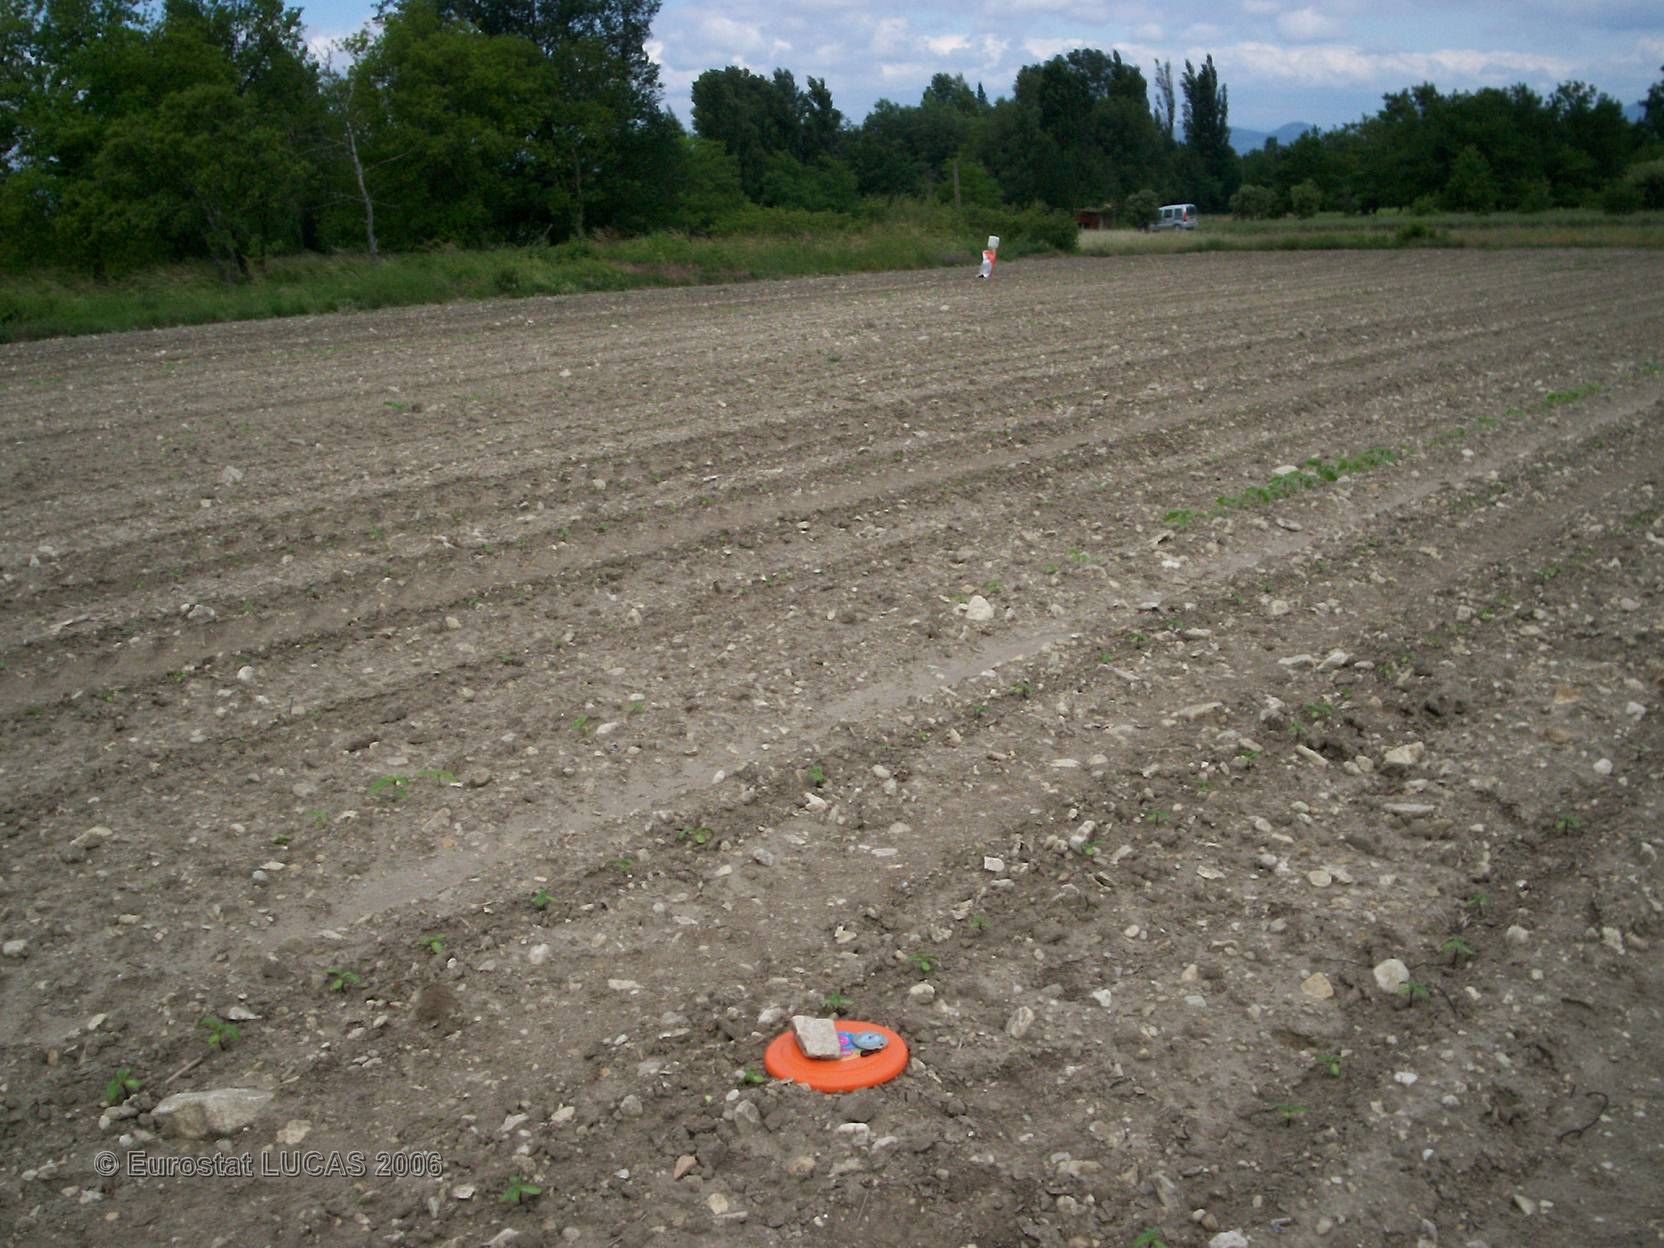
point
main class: Cropland
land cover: Sunflower
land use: Agriculture (excluding fallow land and kitchen gardens)
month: June
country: FR
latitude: 44.5328
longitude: 4.9103
